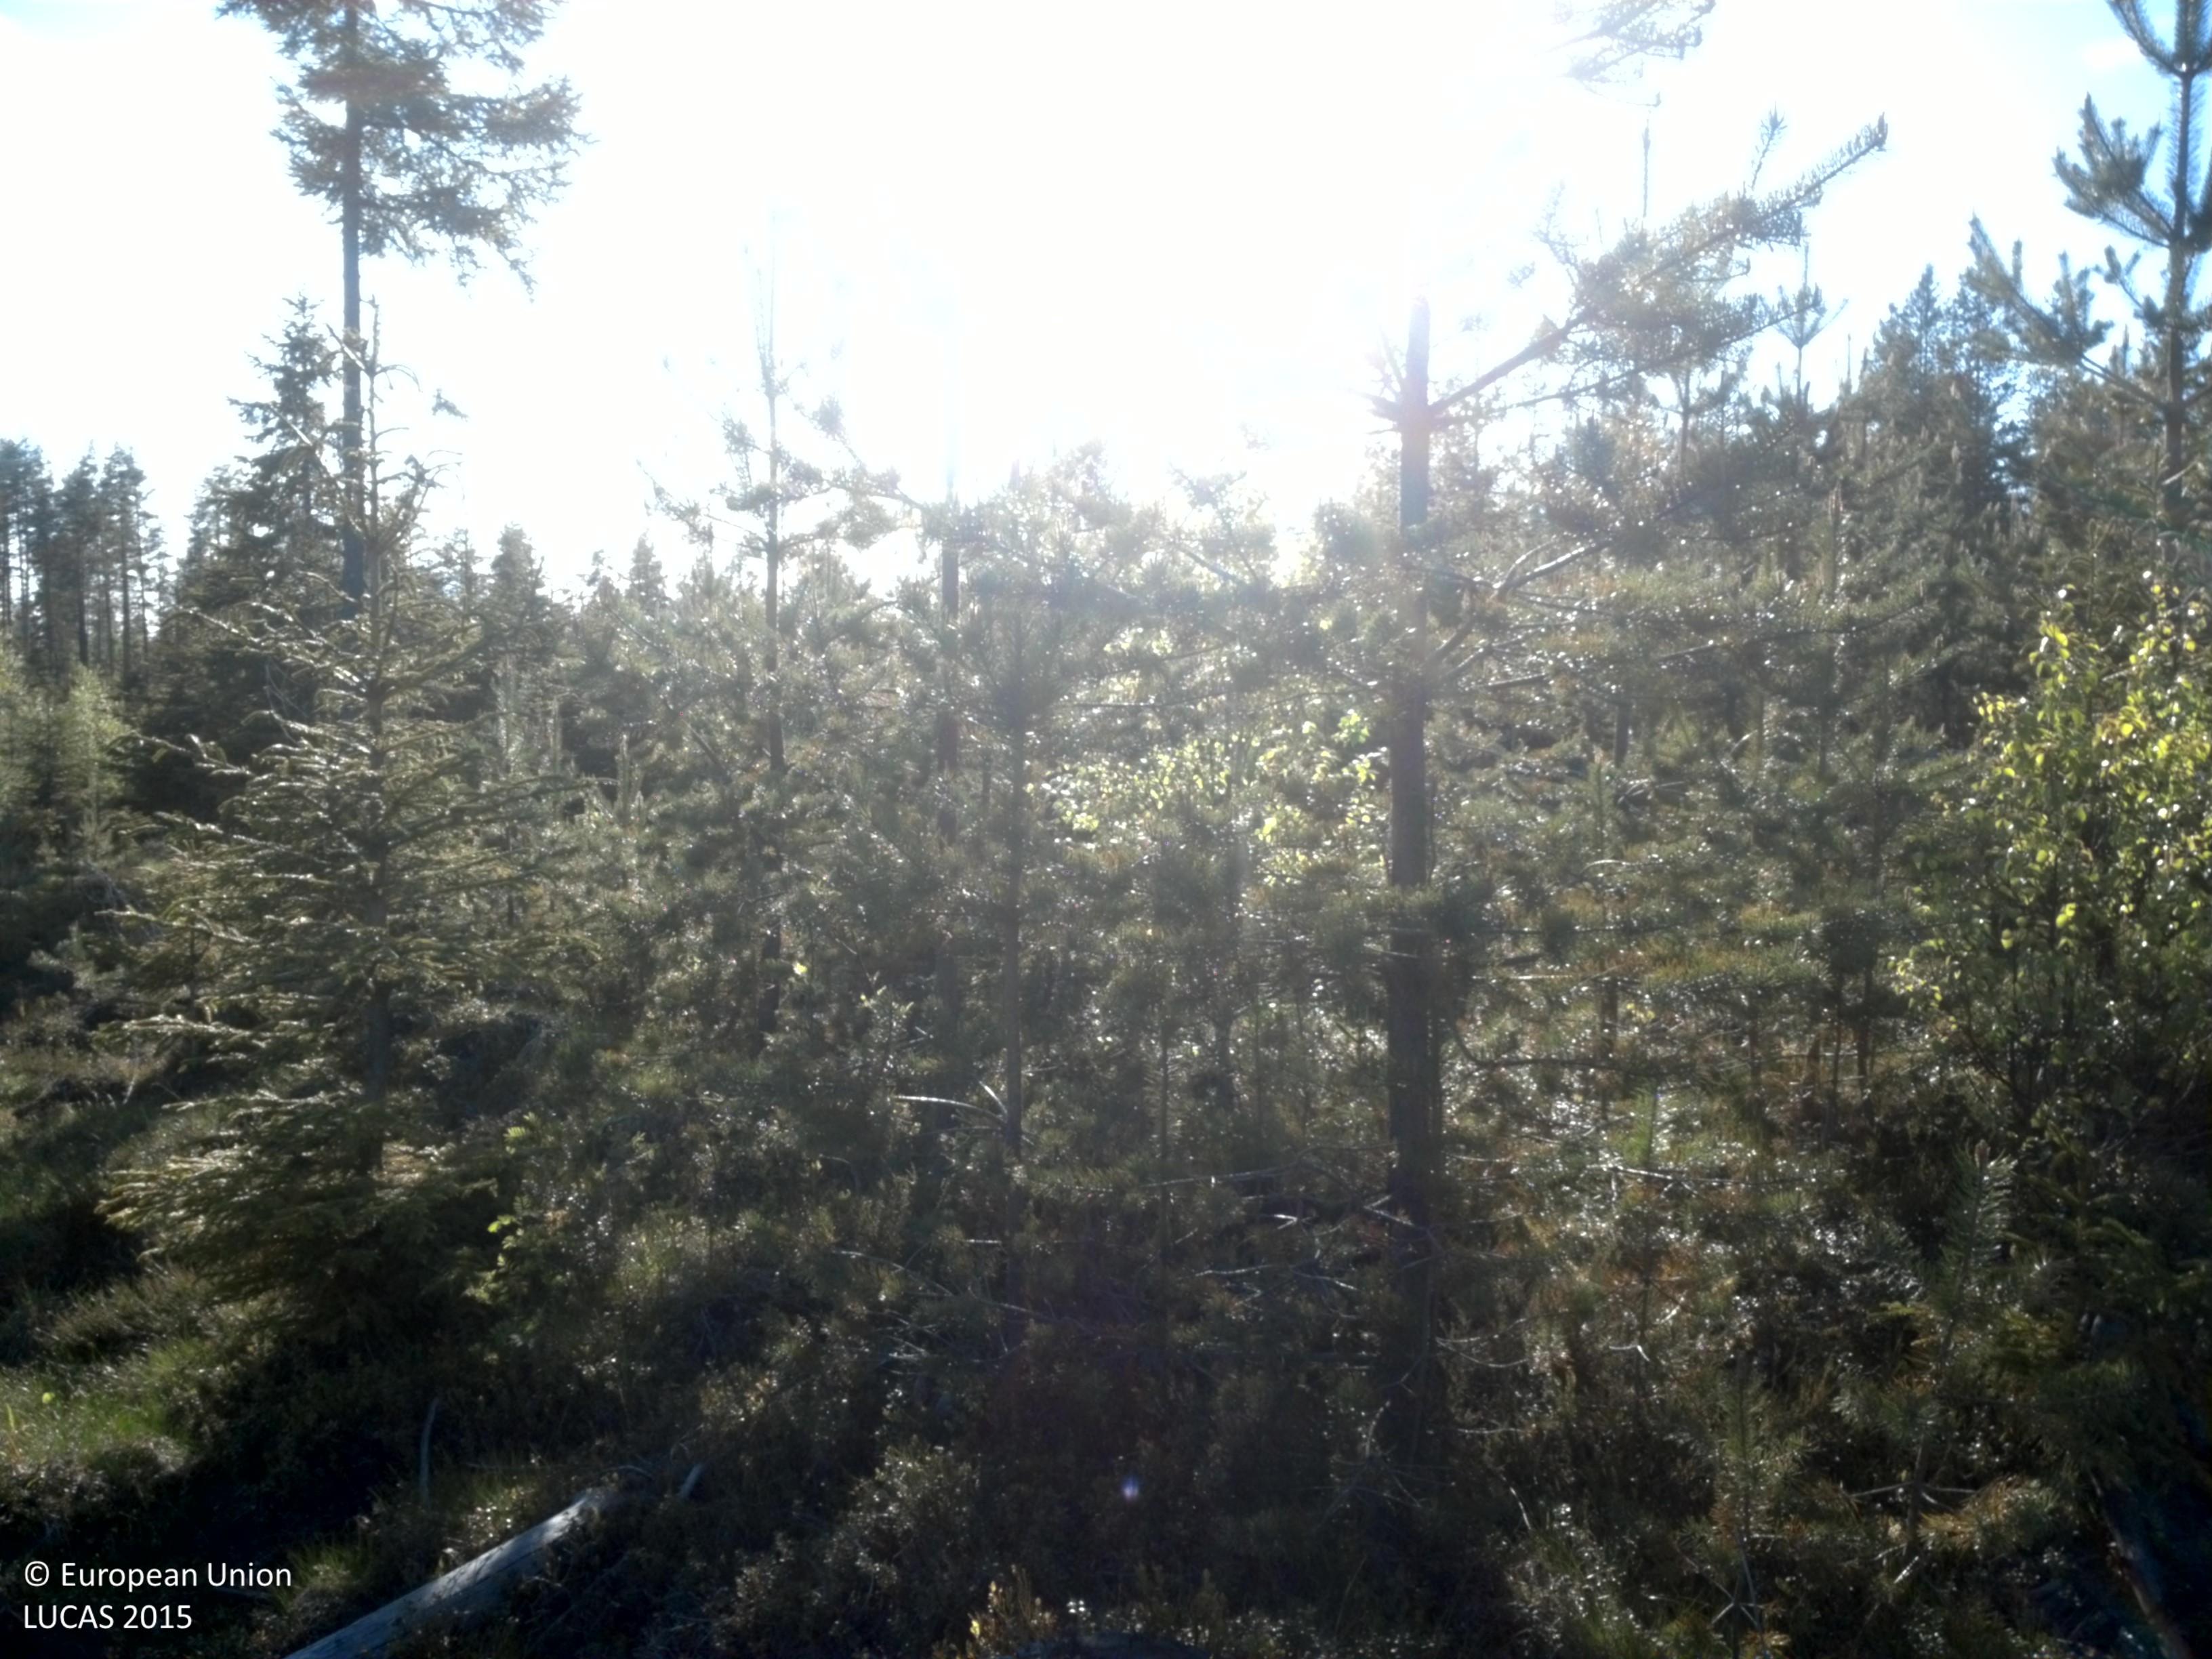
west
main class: Woodland
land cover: Other mixed woodland
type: boreal forest
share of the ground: 25 - 50 %
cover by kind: herbaceous plants 40 %, coniferous forest trees 30 %, broadleaved forest trees 20 %, shrubs 10 %
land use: Forestry
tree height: < 5 m
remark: Clear cut
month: June
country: SE
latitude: 63.9841
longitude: 20.3822
